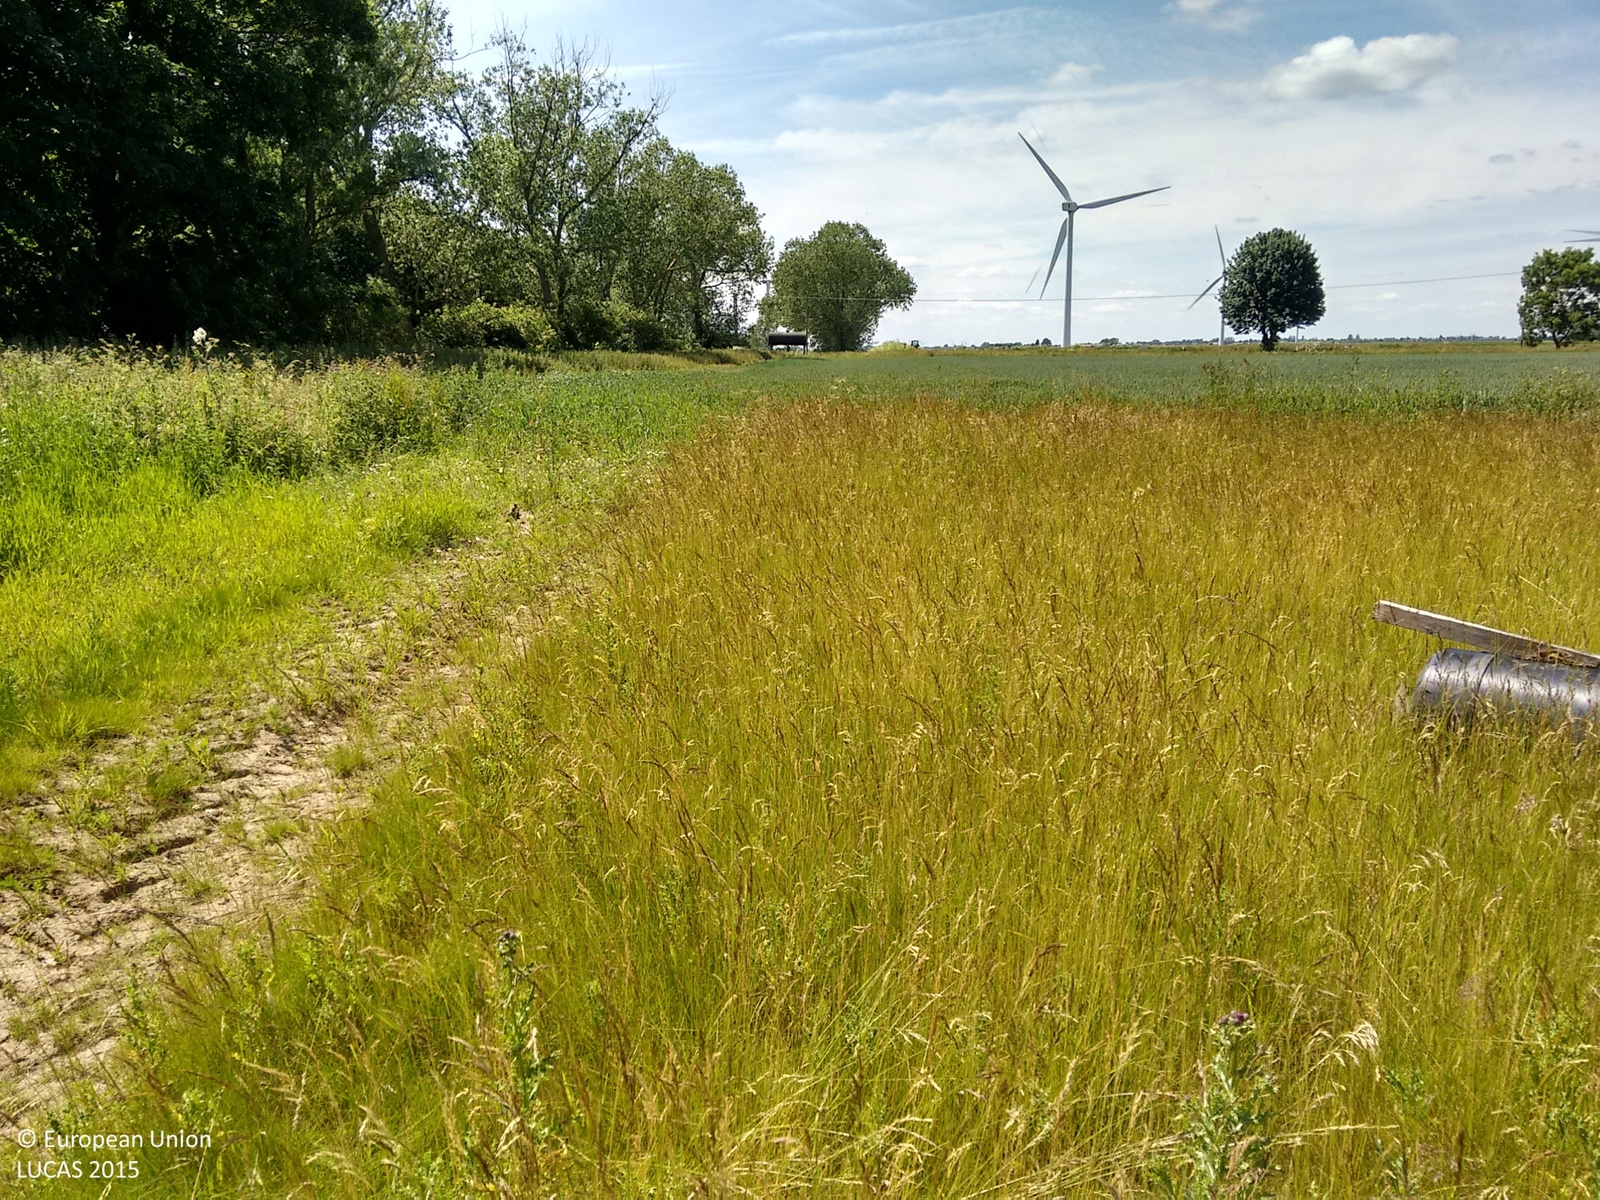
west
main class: Grassland
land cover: Spontaneously vegetated surfaces
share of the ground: > 75 %
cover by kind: herbaceous plants 100 %
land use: Energy production
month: June
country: GB
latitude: 52.5832
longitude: 0.1546
